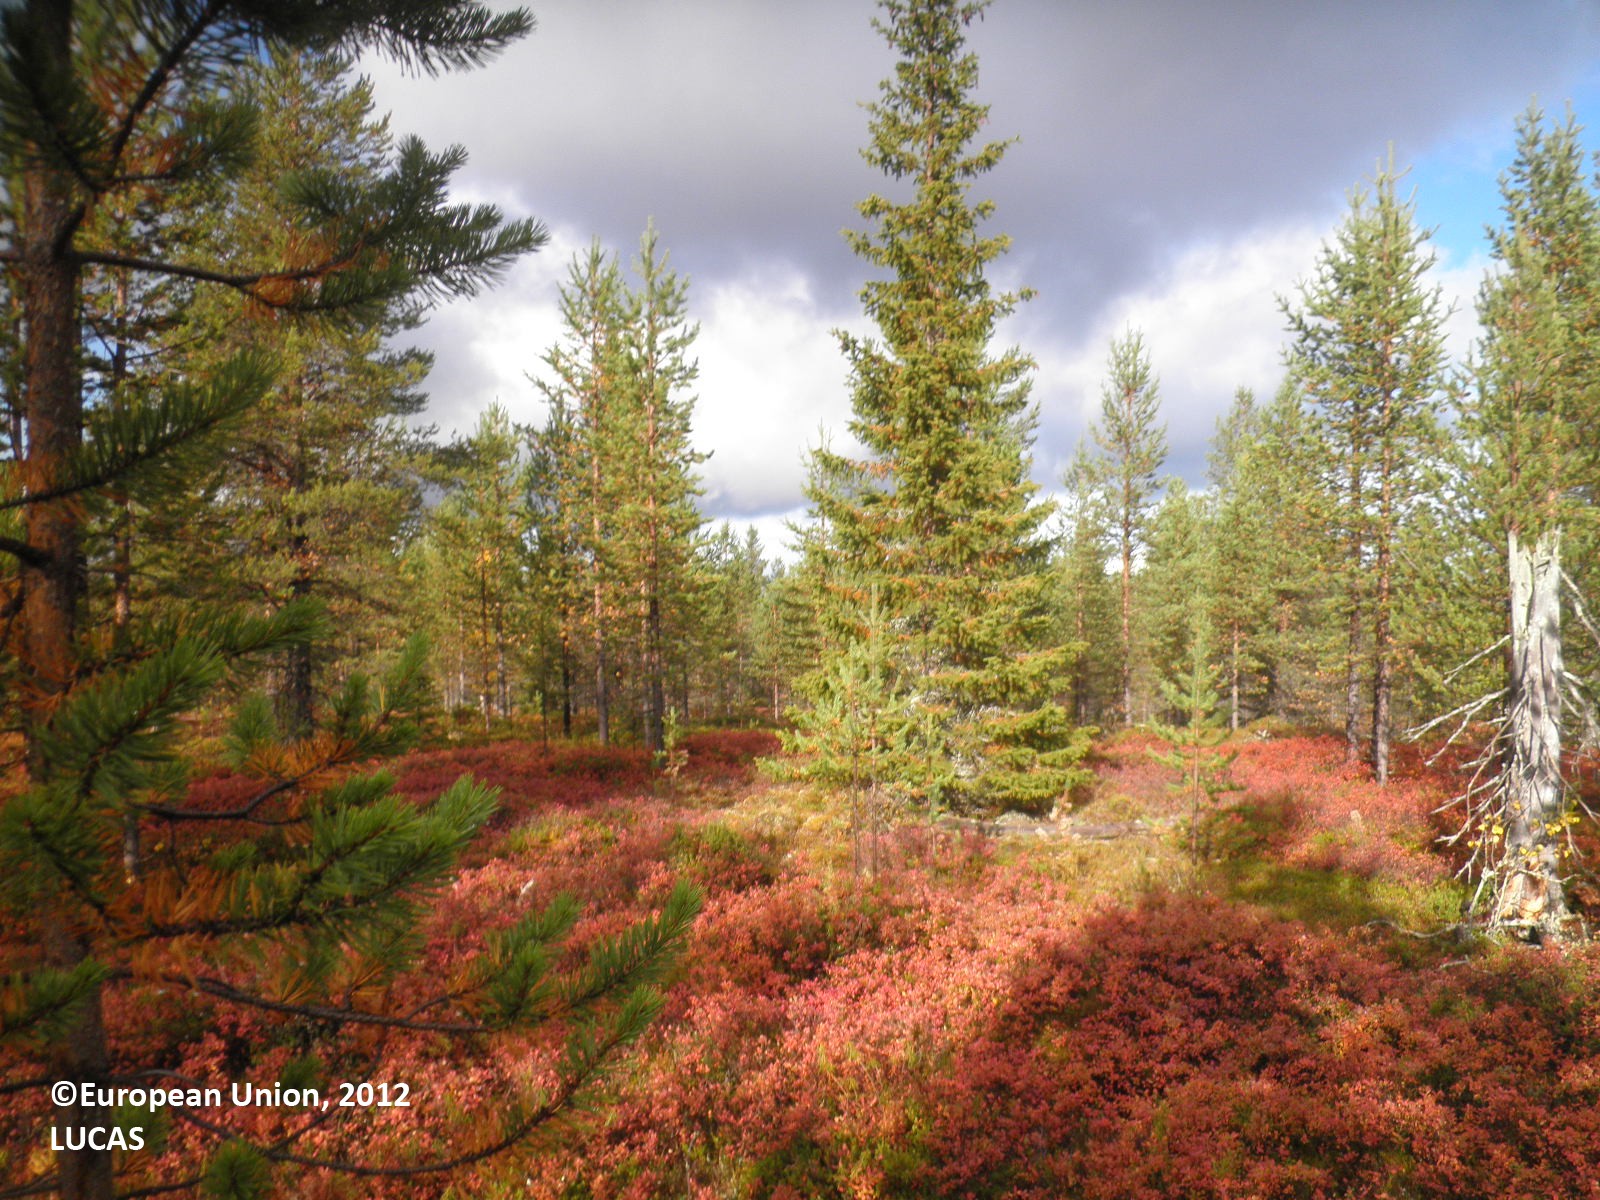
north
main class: Woodland
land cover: Pine dominated coniferous woodland
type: boreal forest
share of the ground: 25 - 50 %
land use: Forestry
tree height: > 5 m
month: September
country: FI
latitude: 67.6731
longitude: 28.6960
